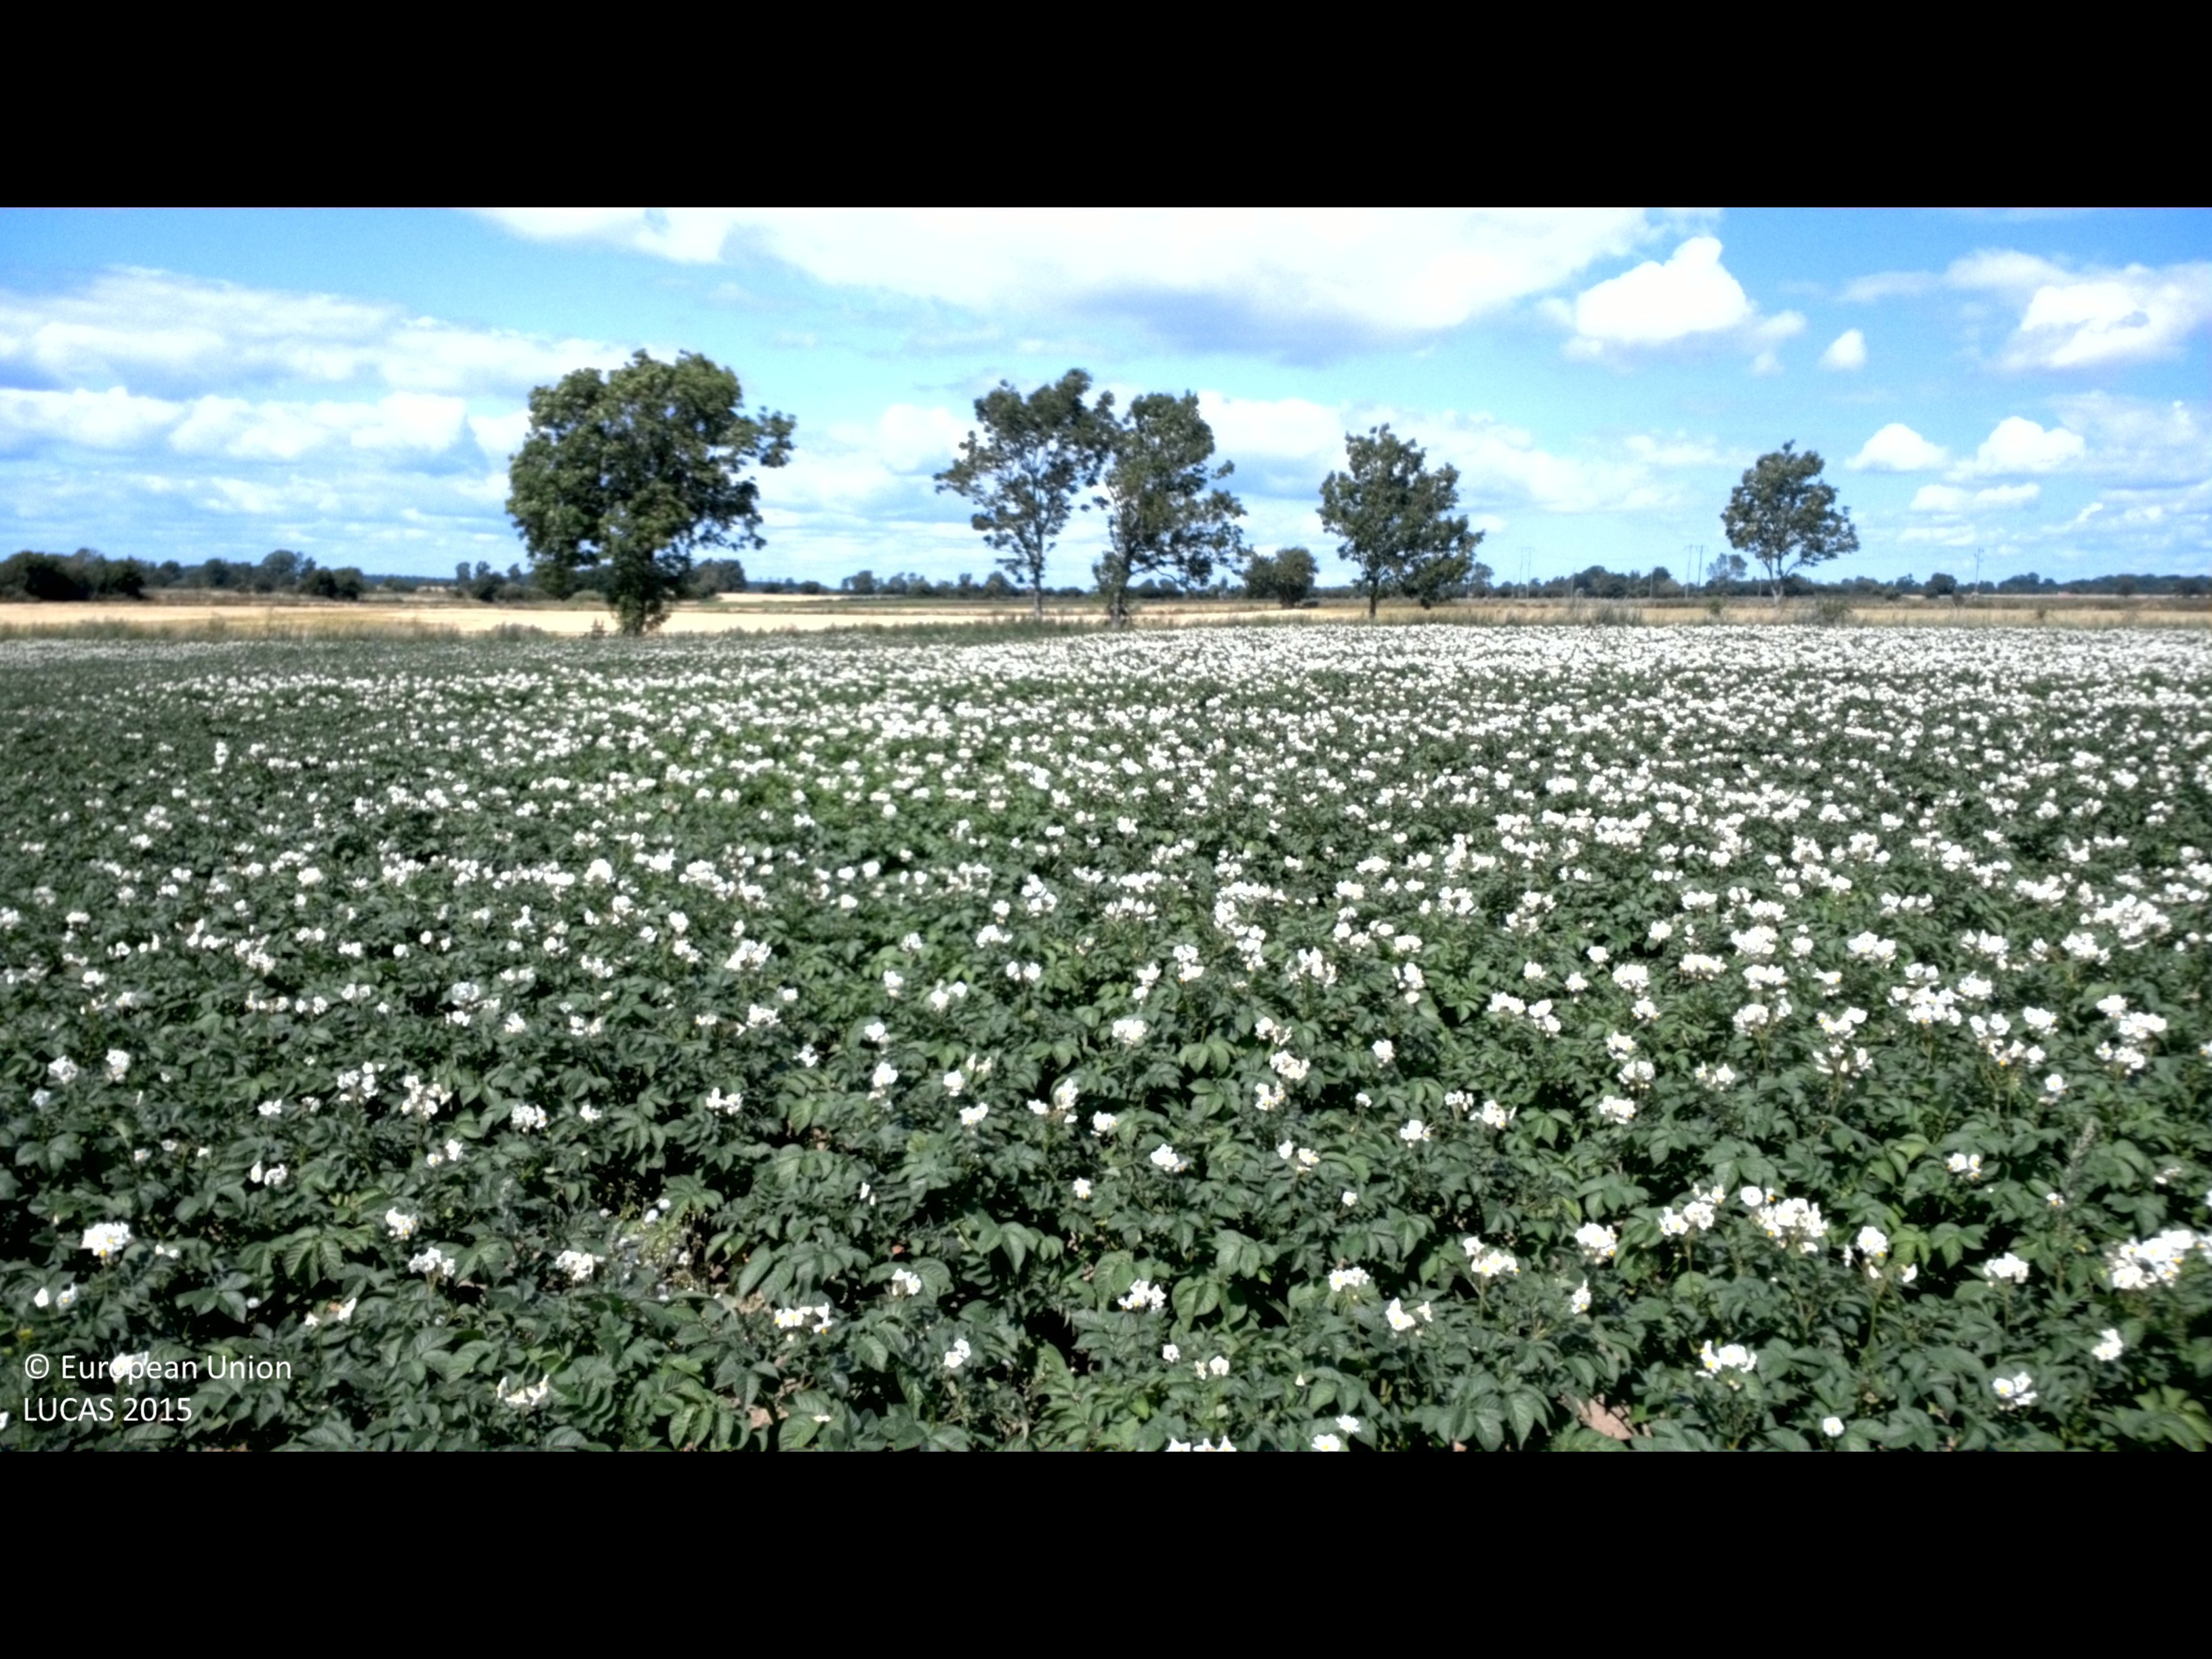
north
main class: Cropland
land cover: Potatoes
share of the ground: > 75 %
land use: Agriculture (excluding fallow land and kitchen gardens)
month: July
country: SE
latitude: 56.4426
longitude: 16.4088
